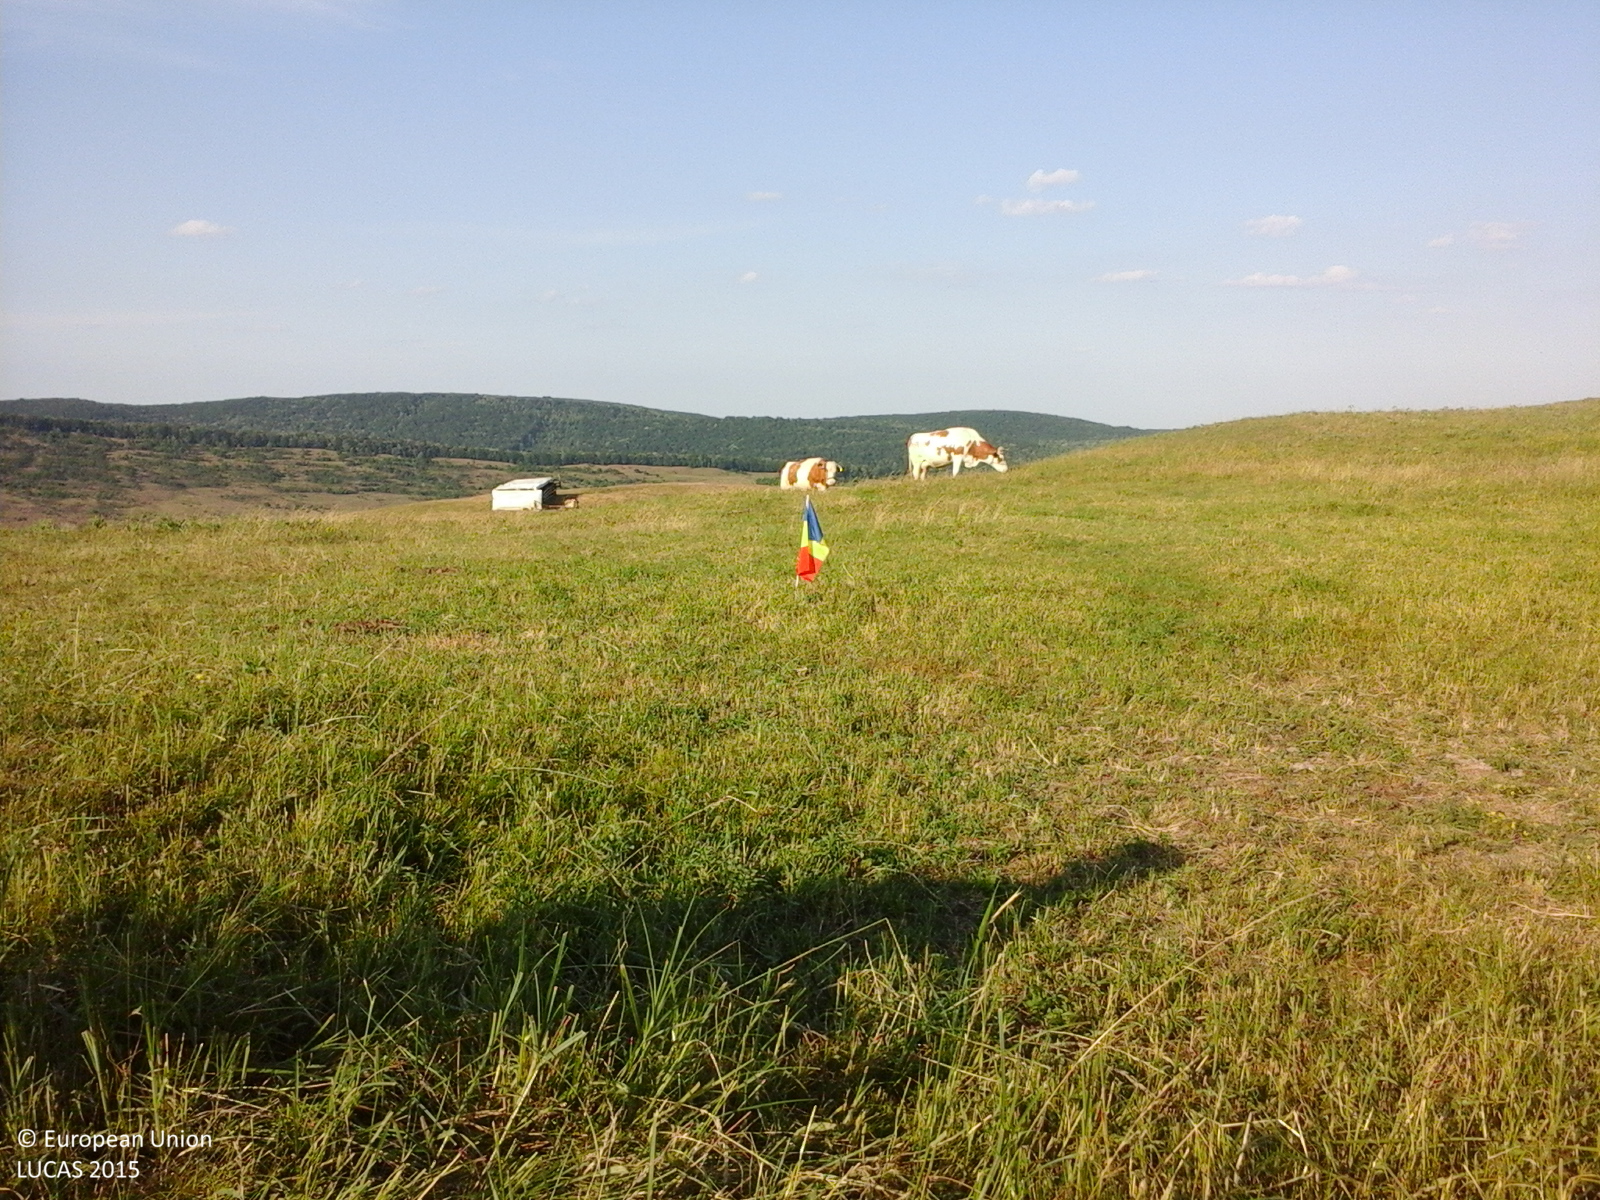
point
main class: Grassland
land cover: Grassland without tree/shrub cover
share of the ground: > 75 %
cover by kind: herbaceous plants 100 %
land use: Agriculture (excluding fallow land and kitchen gardens)
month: June
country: RO
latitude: 47.6746
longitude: 26.5679
